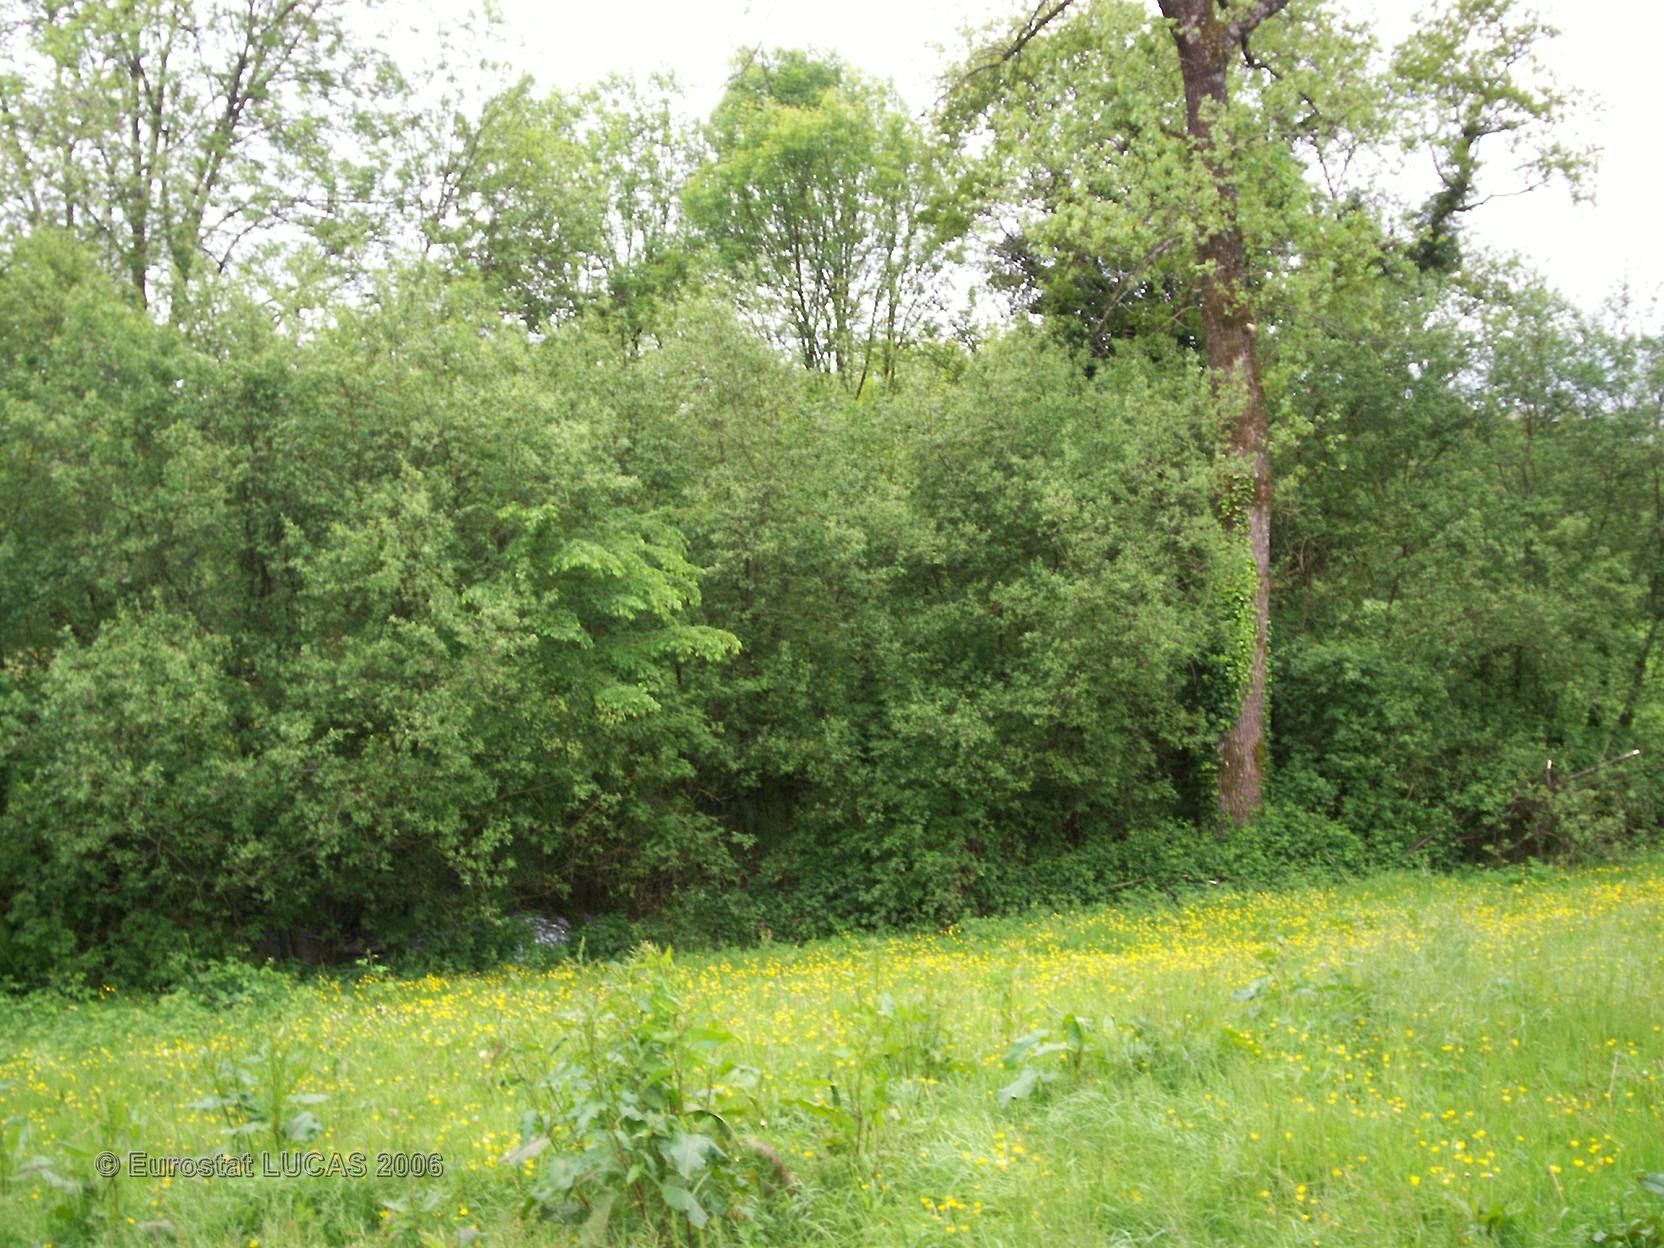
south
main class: Grassland
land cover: Grassland without tree/shrub cover
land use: Agriculture (excluding fallow land and kitchen gardens)
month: May
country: FR
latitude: 48.0686
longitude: -3.8940
